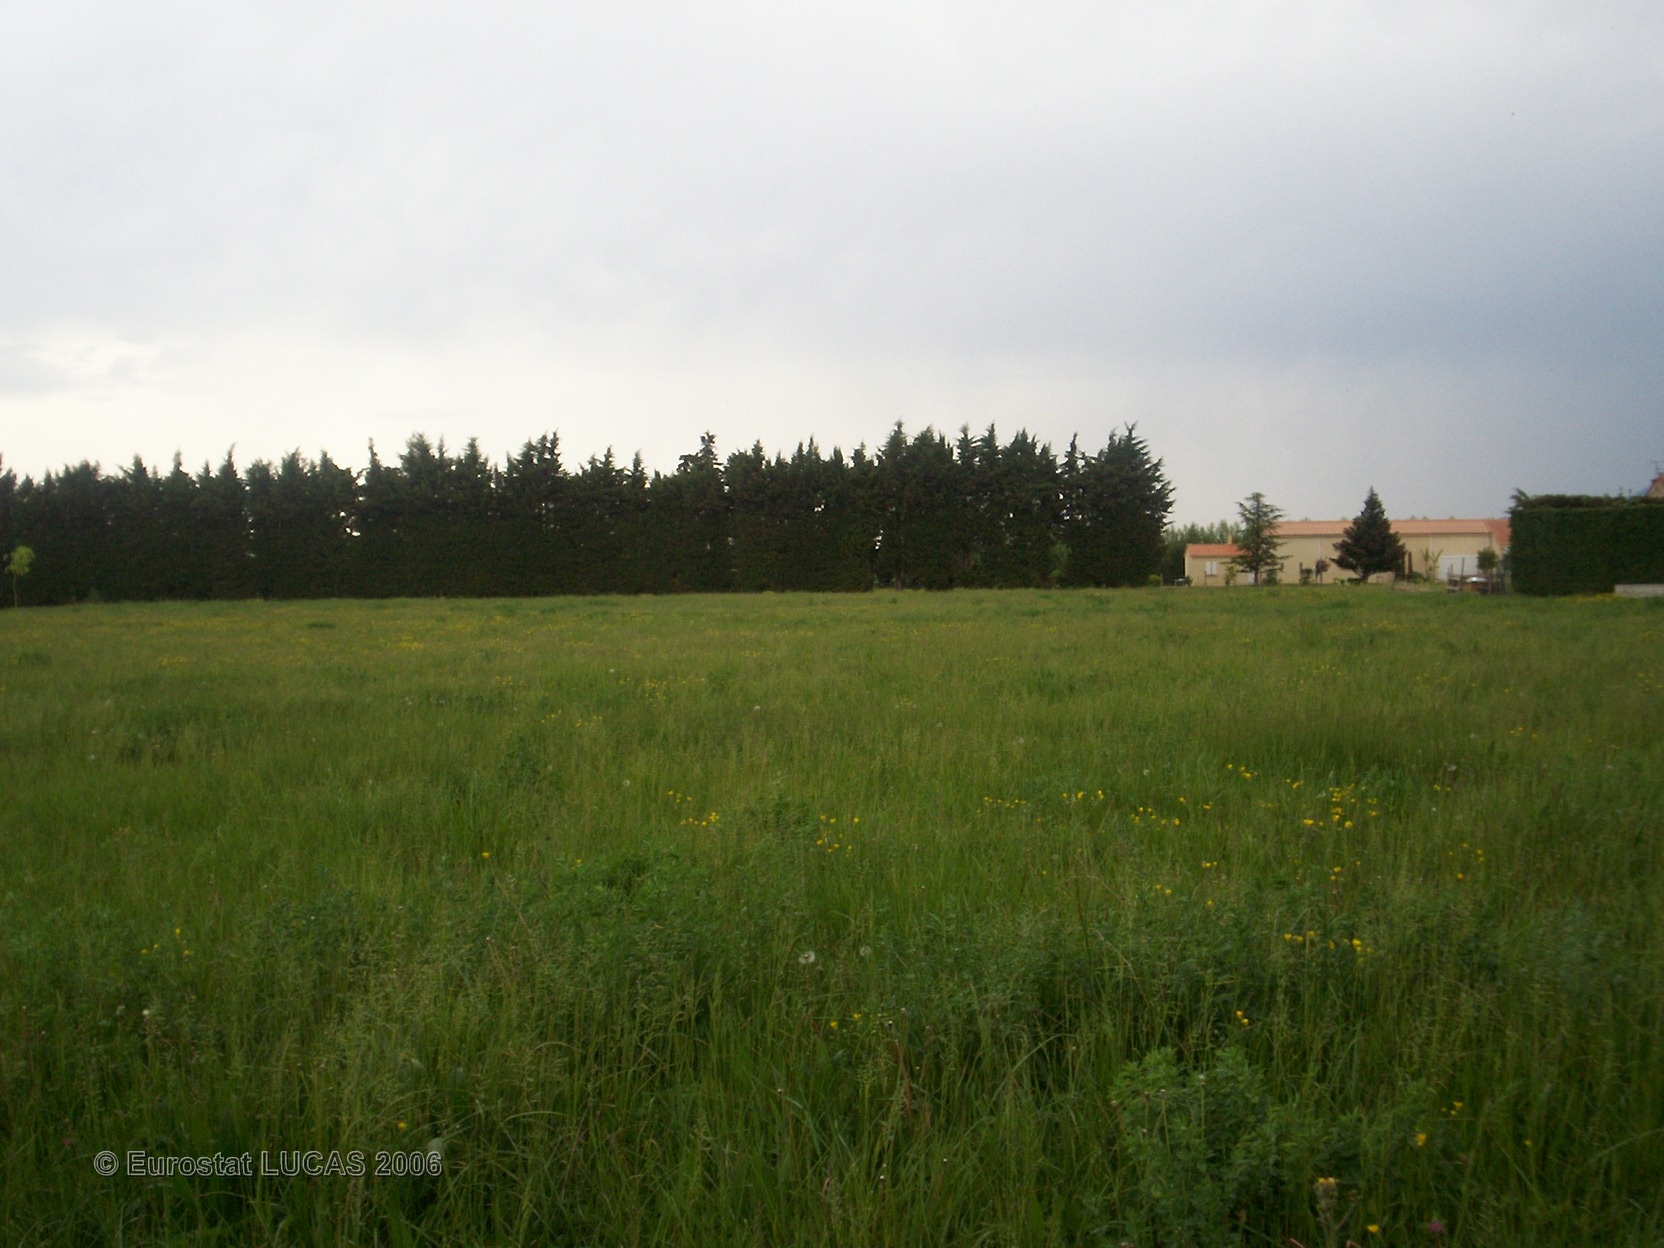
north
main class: Grassland
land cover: Grassland without tree/shrub cover
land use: Agriculture (excluding fallow land and kitchen gardens)
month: April
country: FR
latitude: 44.0483
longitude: 4.9784
